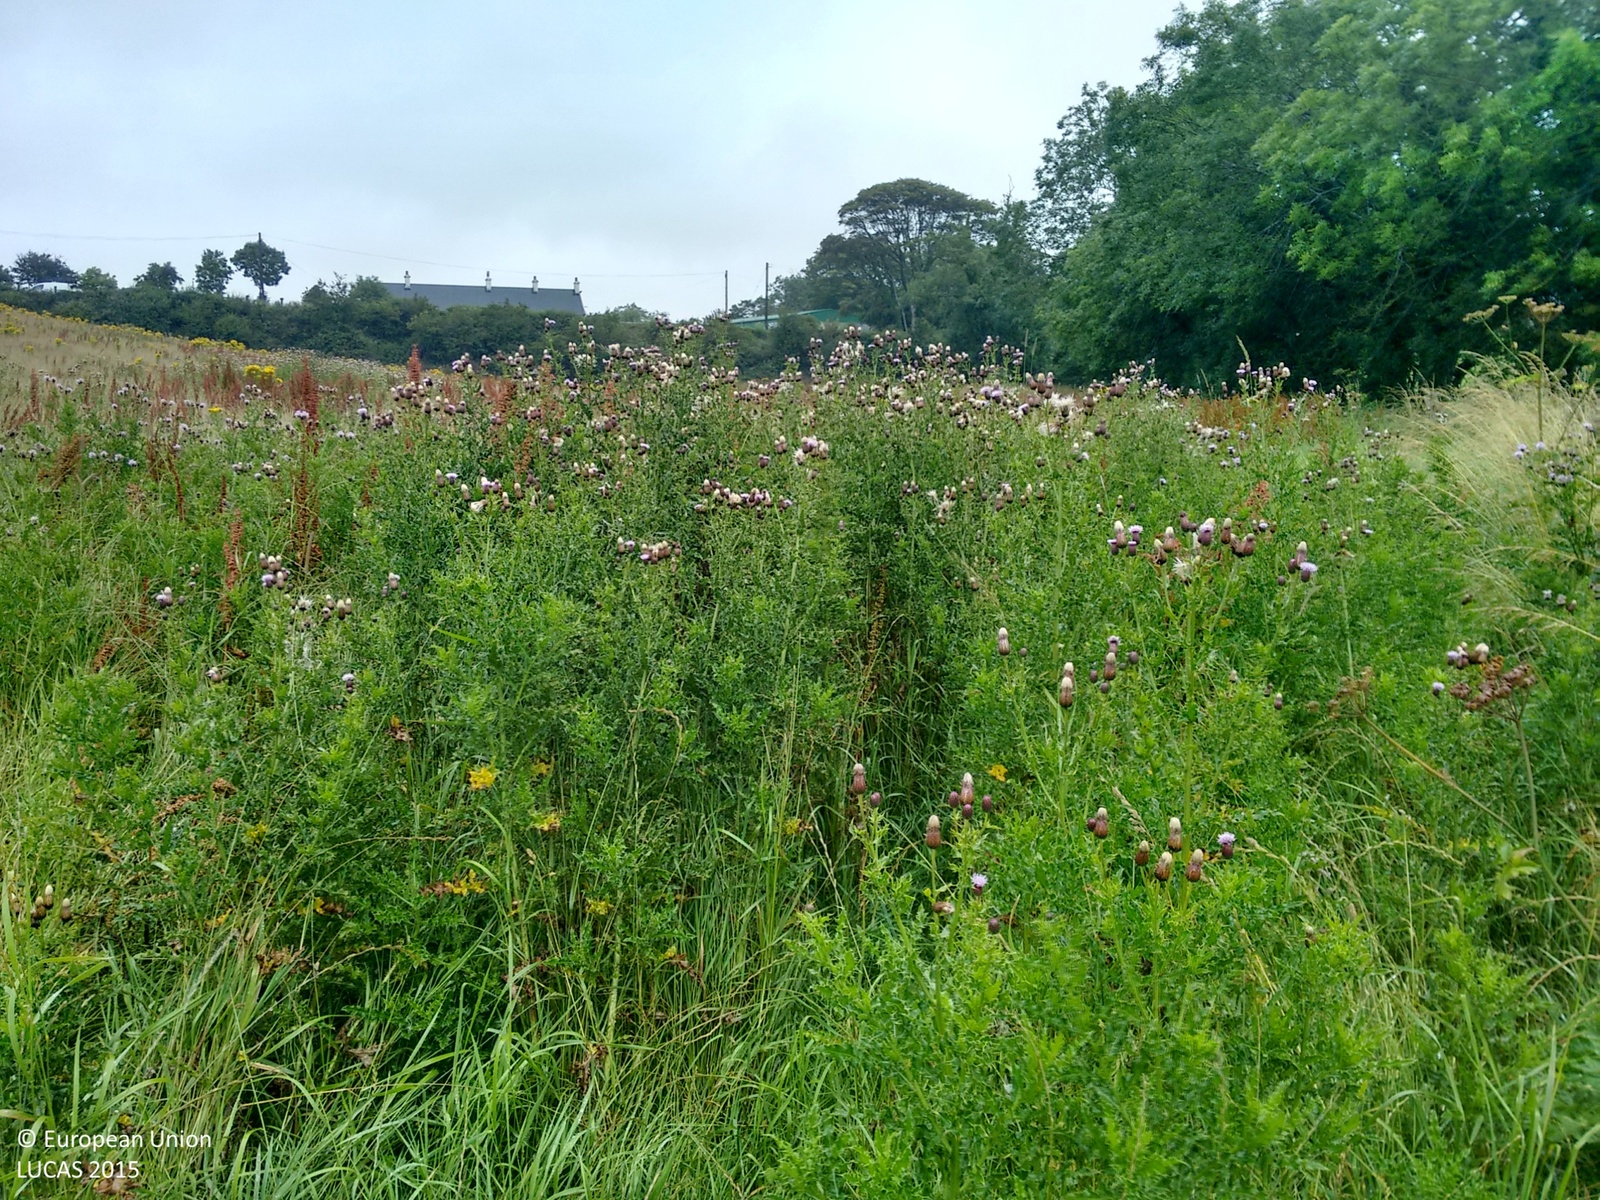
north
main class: Grassland
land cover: Grassland without tree/shrub cover
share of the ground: > 75 %
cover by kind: herbaceous plants 100 %
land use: Agriculture (excluding fallow land and kitchen gardens)
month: August
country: GB
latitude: 54.3046
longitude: -5.7642
